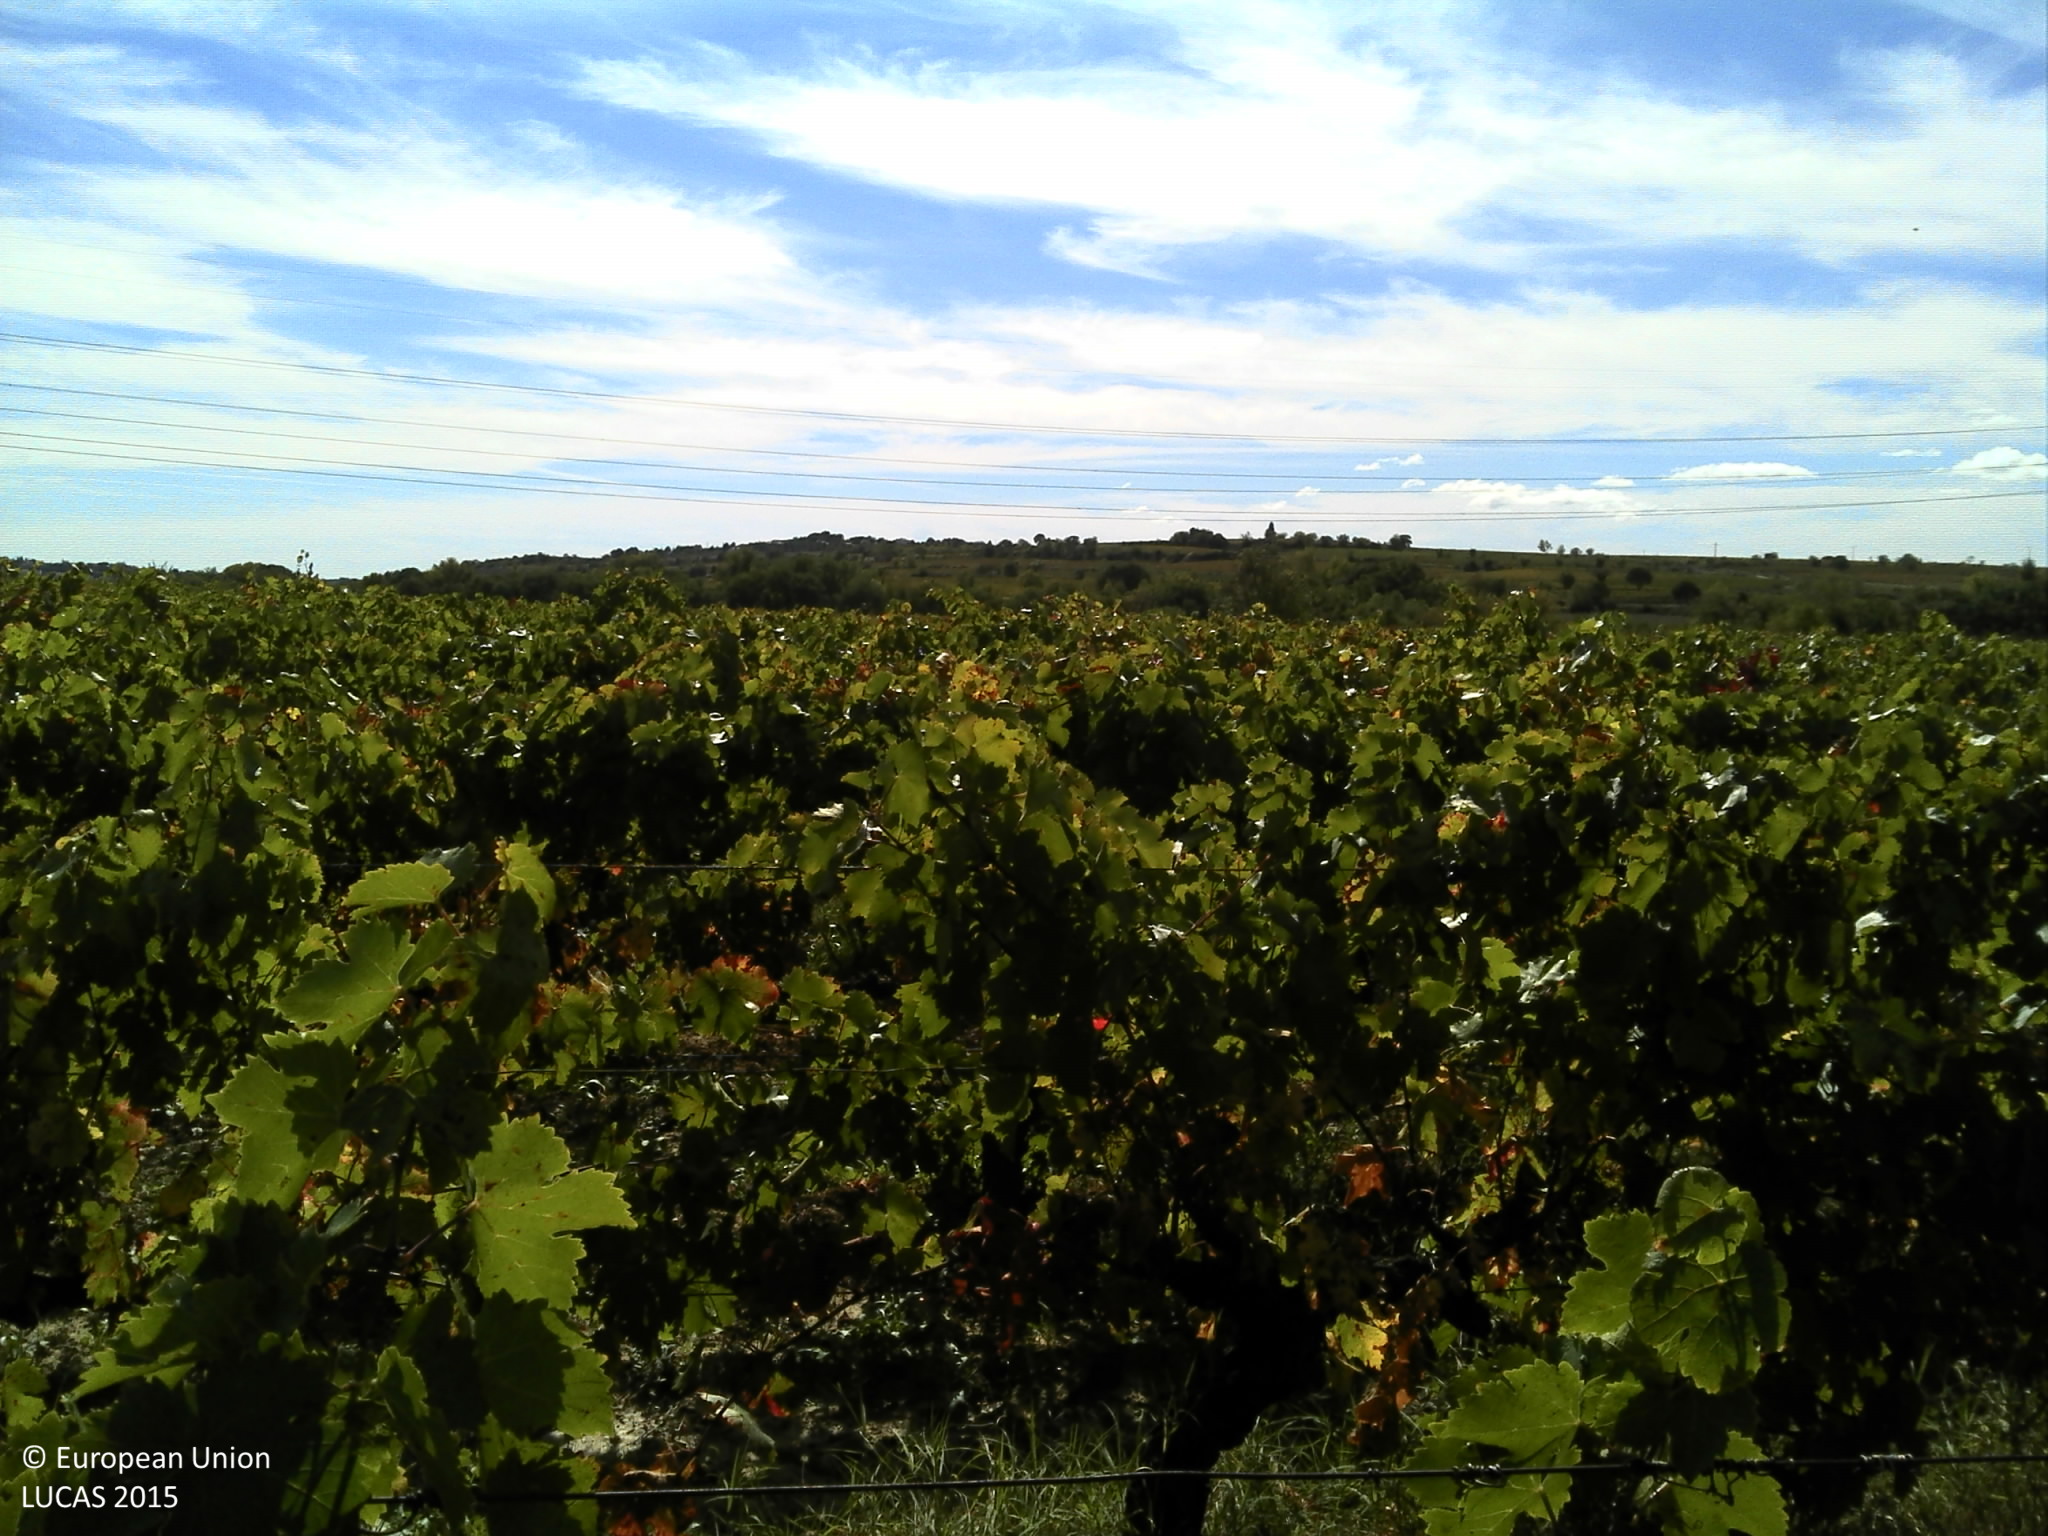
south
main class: Cropland
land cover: Vineyards
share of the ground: 10 - 25 %
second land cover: Spontaneously vegetated surfaces
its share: 50 - 75 %
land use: Agriculture (excluding fallow land and kitchen gardens)
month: October
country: FR
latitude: 43.4936
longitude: 3.1950
